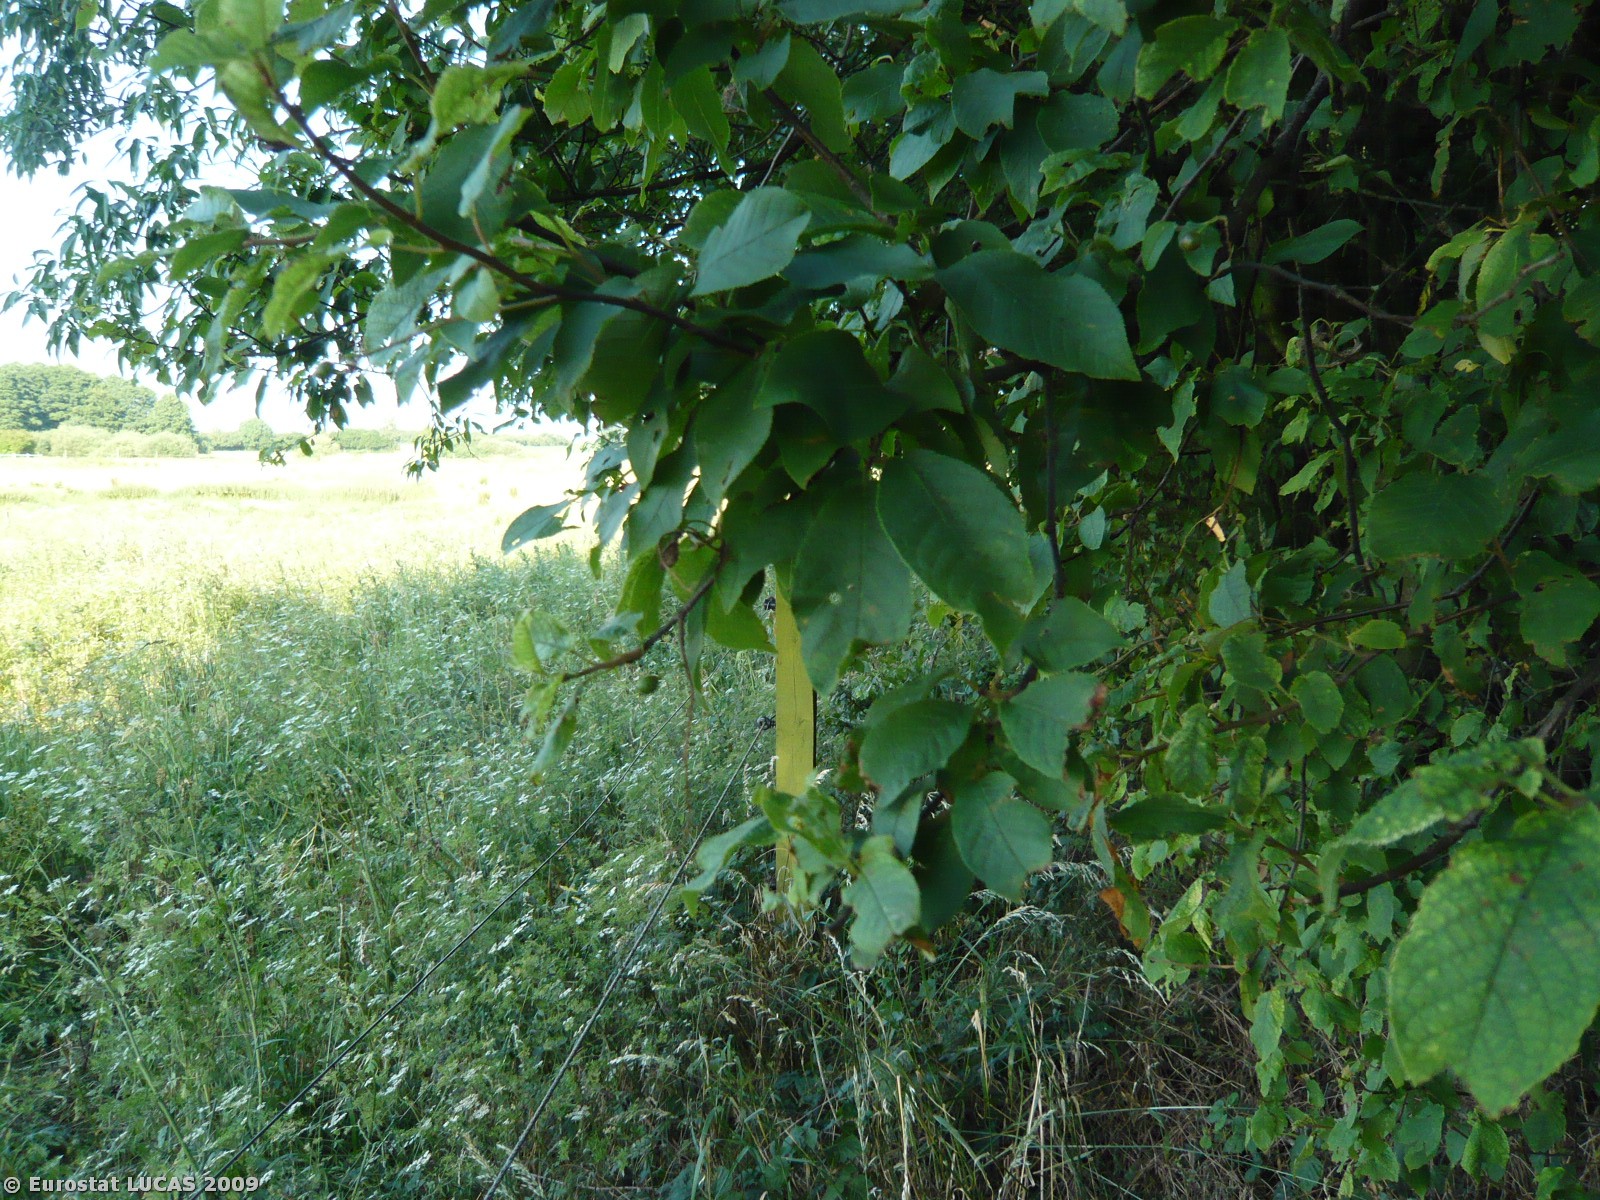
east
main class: Woodland
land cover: Broadleaved woodland
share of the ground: > 75 %
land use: Unused
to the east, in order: Broadleaved woodland; Fences; Grassland without tree/shrub cover; Fences; Grass margins; Fences; Grassland without tree/shrub cover; Fences; Grass margins; Tracks; Grassland without tree/shrub cover; Broadleaved woodland; Fences; Grassland without tree/shrub cover
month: July
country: DK
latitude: 55.4325
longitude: 10.2684
